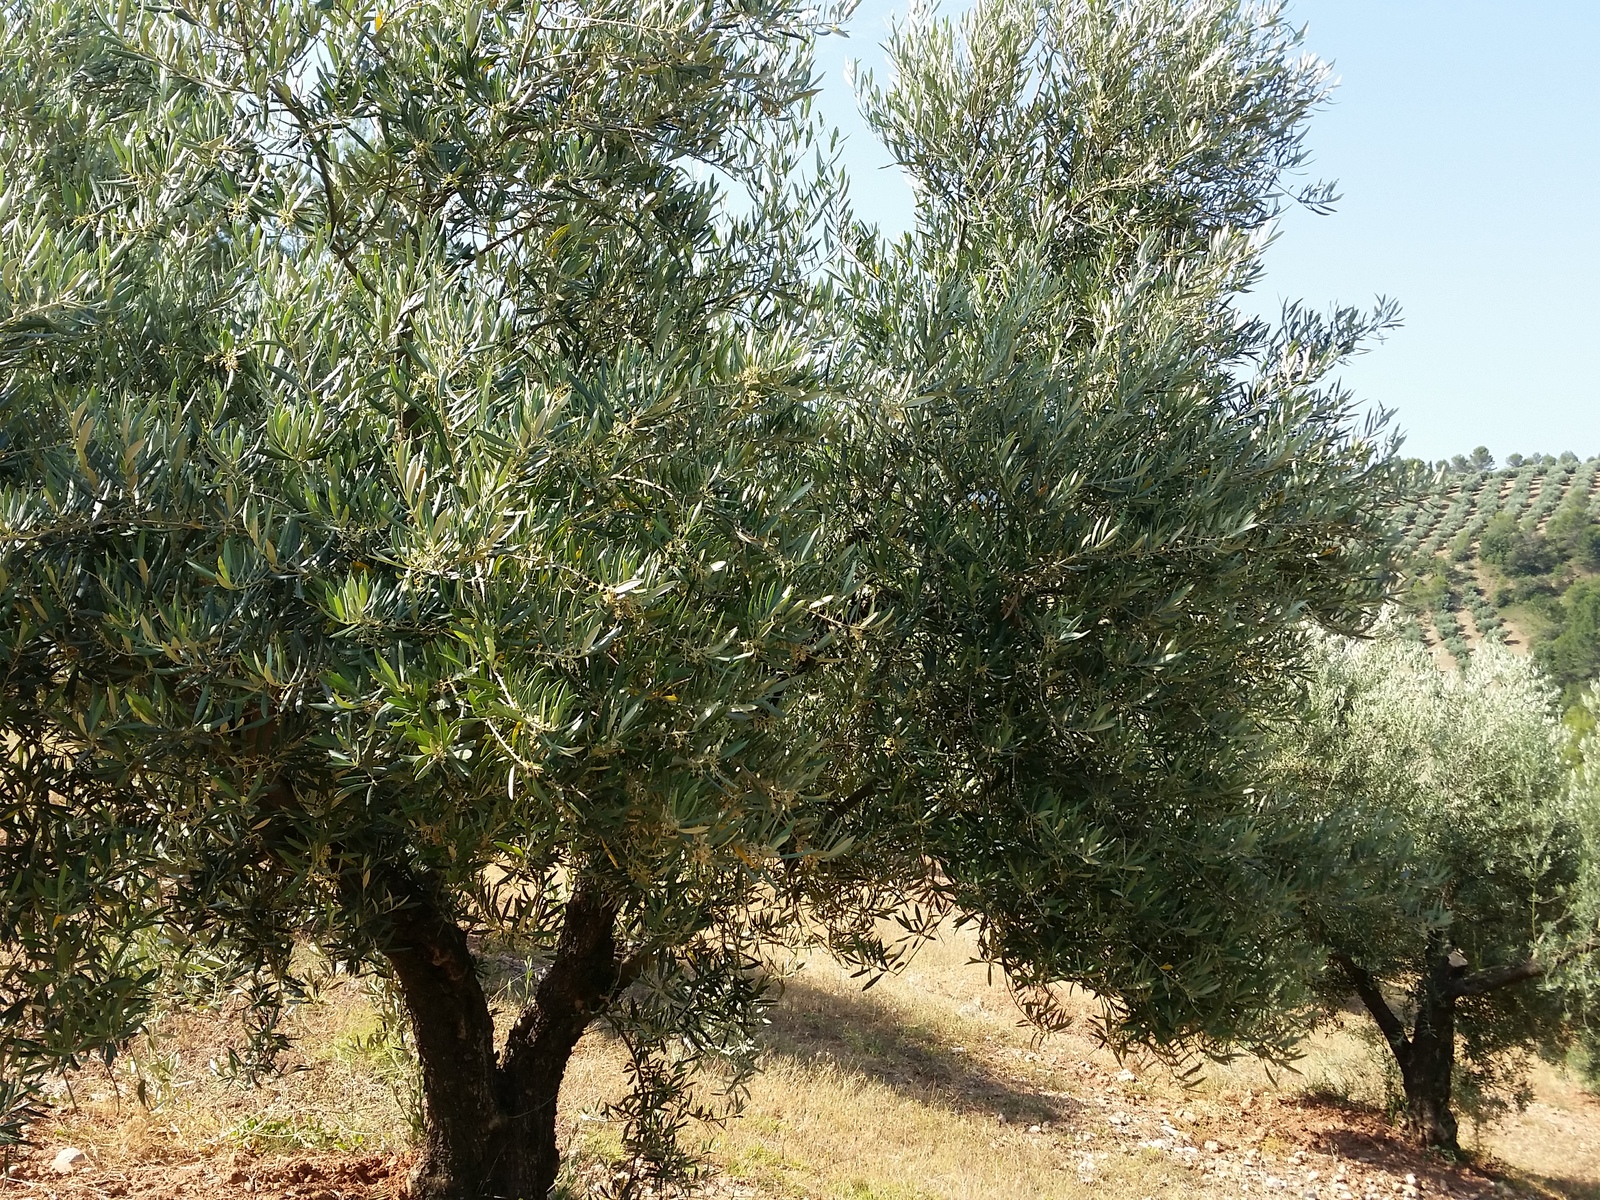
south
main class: Cropland
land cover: Olive groves
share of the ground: 50 - 75 %
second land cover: Grassland without tree/shrub cover
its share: 25 - 50 %
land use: Agriculture (excluding fallow land and kitchen gardens)
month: June
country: ES
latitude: 38.4163
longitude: -2.5394
